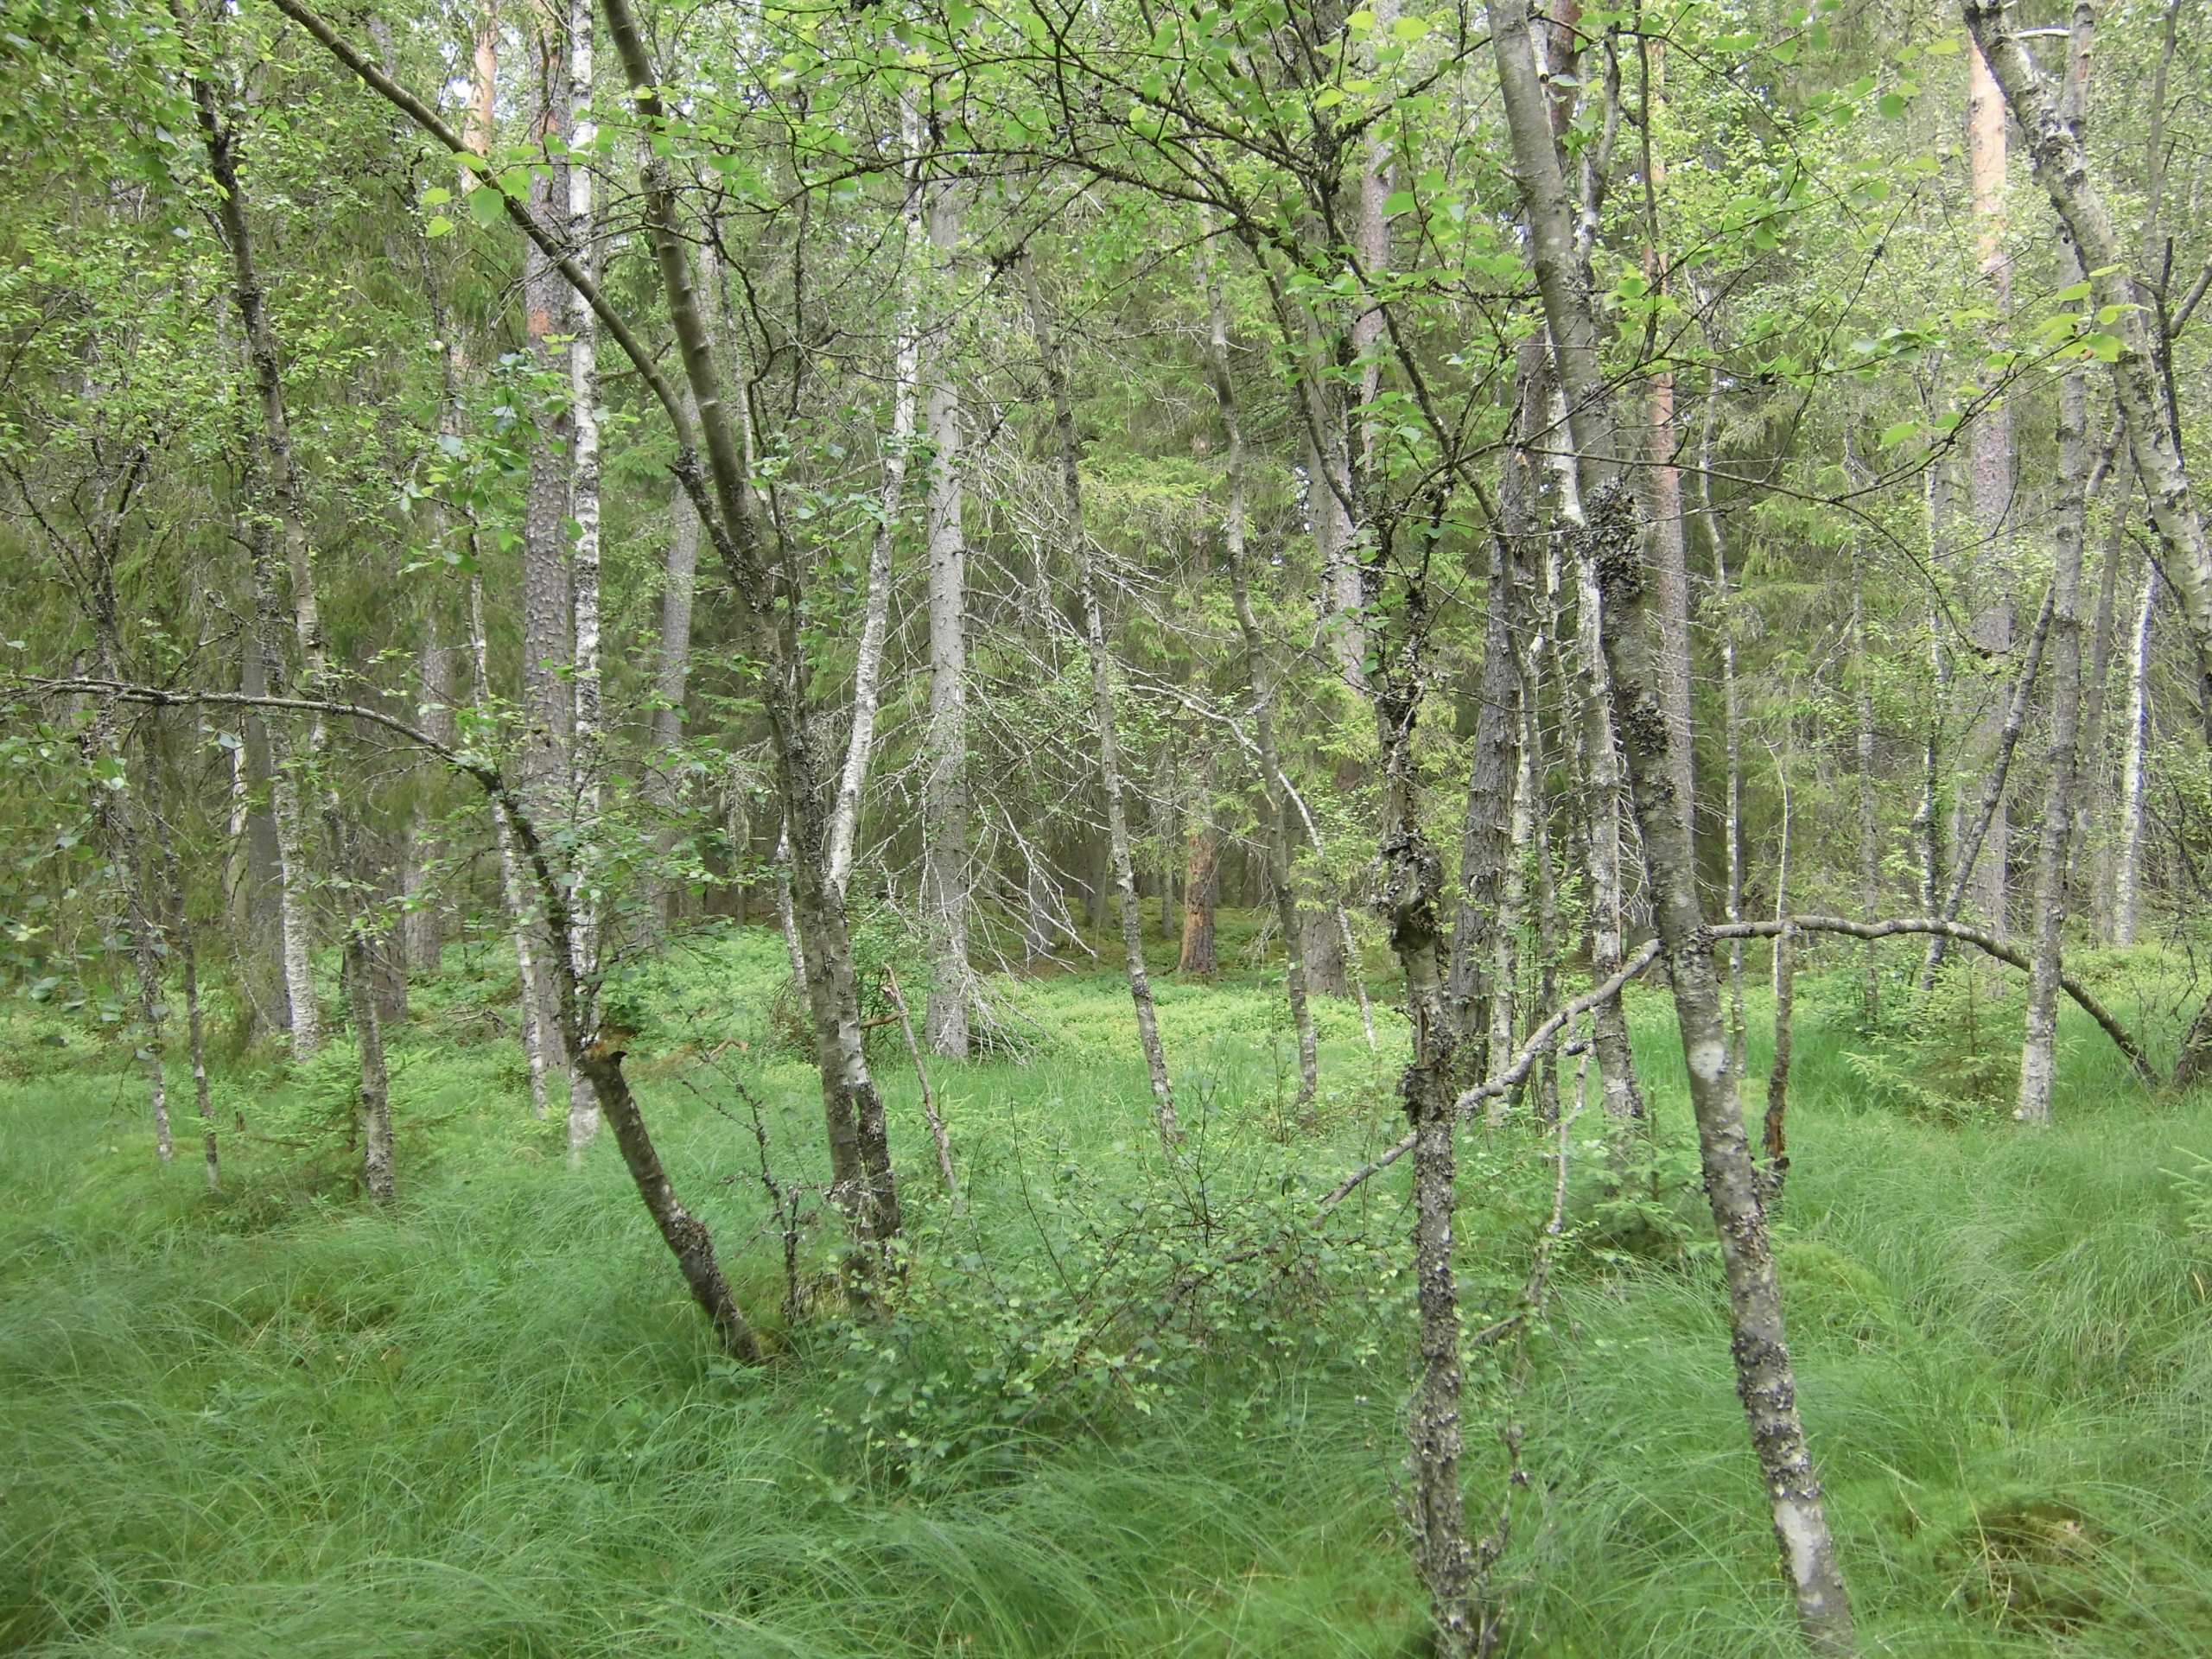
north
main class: Woodland
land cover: Broadleaved woodland
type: mire and swamp forests
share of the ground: 50 - 75 %
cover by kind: broadleaved forest trees 50 %, herbaceous plants 20 %, lichens and mosses 20 %, coniferous forest trees 5 %, shrubs 5 %
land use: Forestry
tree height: > 5 m
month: July
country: SE
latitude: 57.3590
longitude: 14.8003
